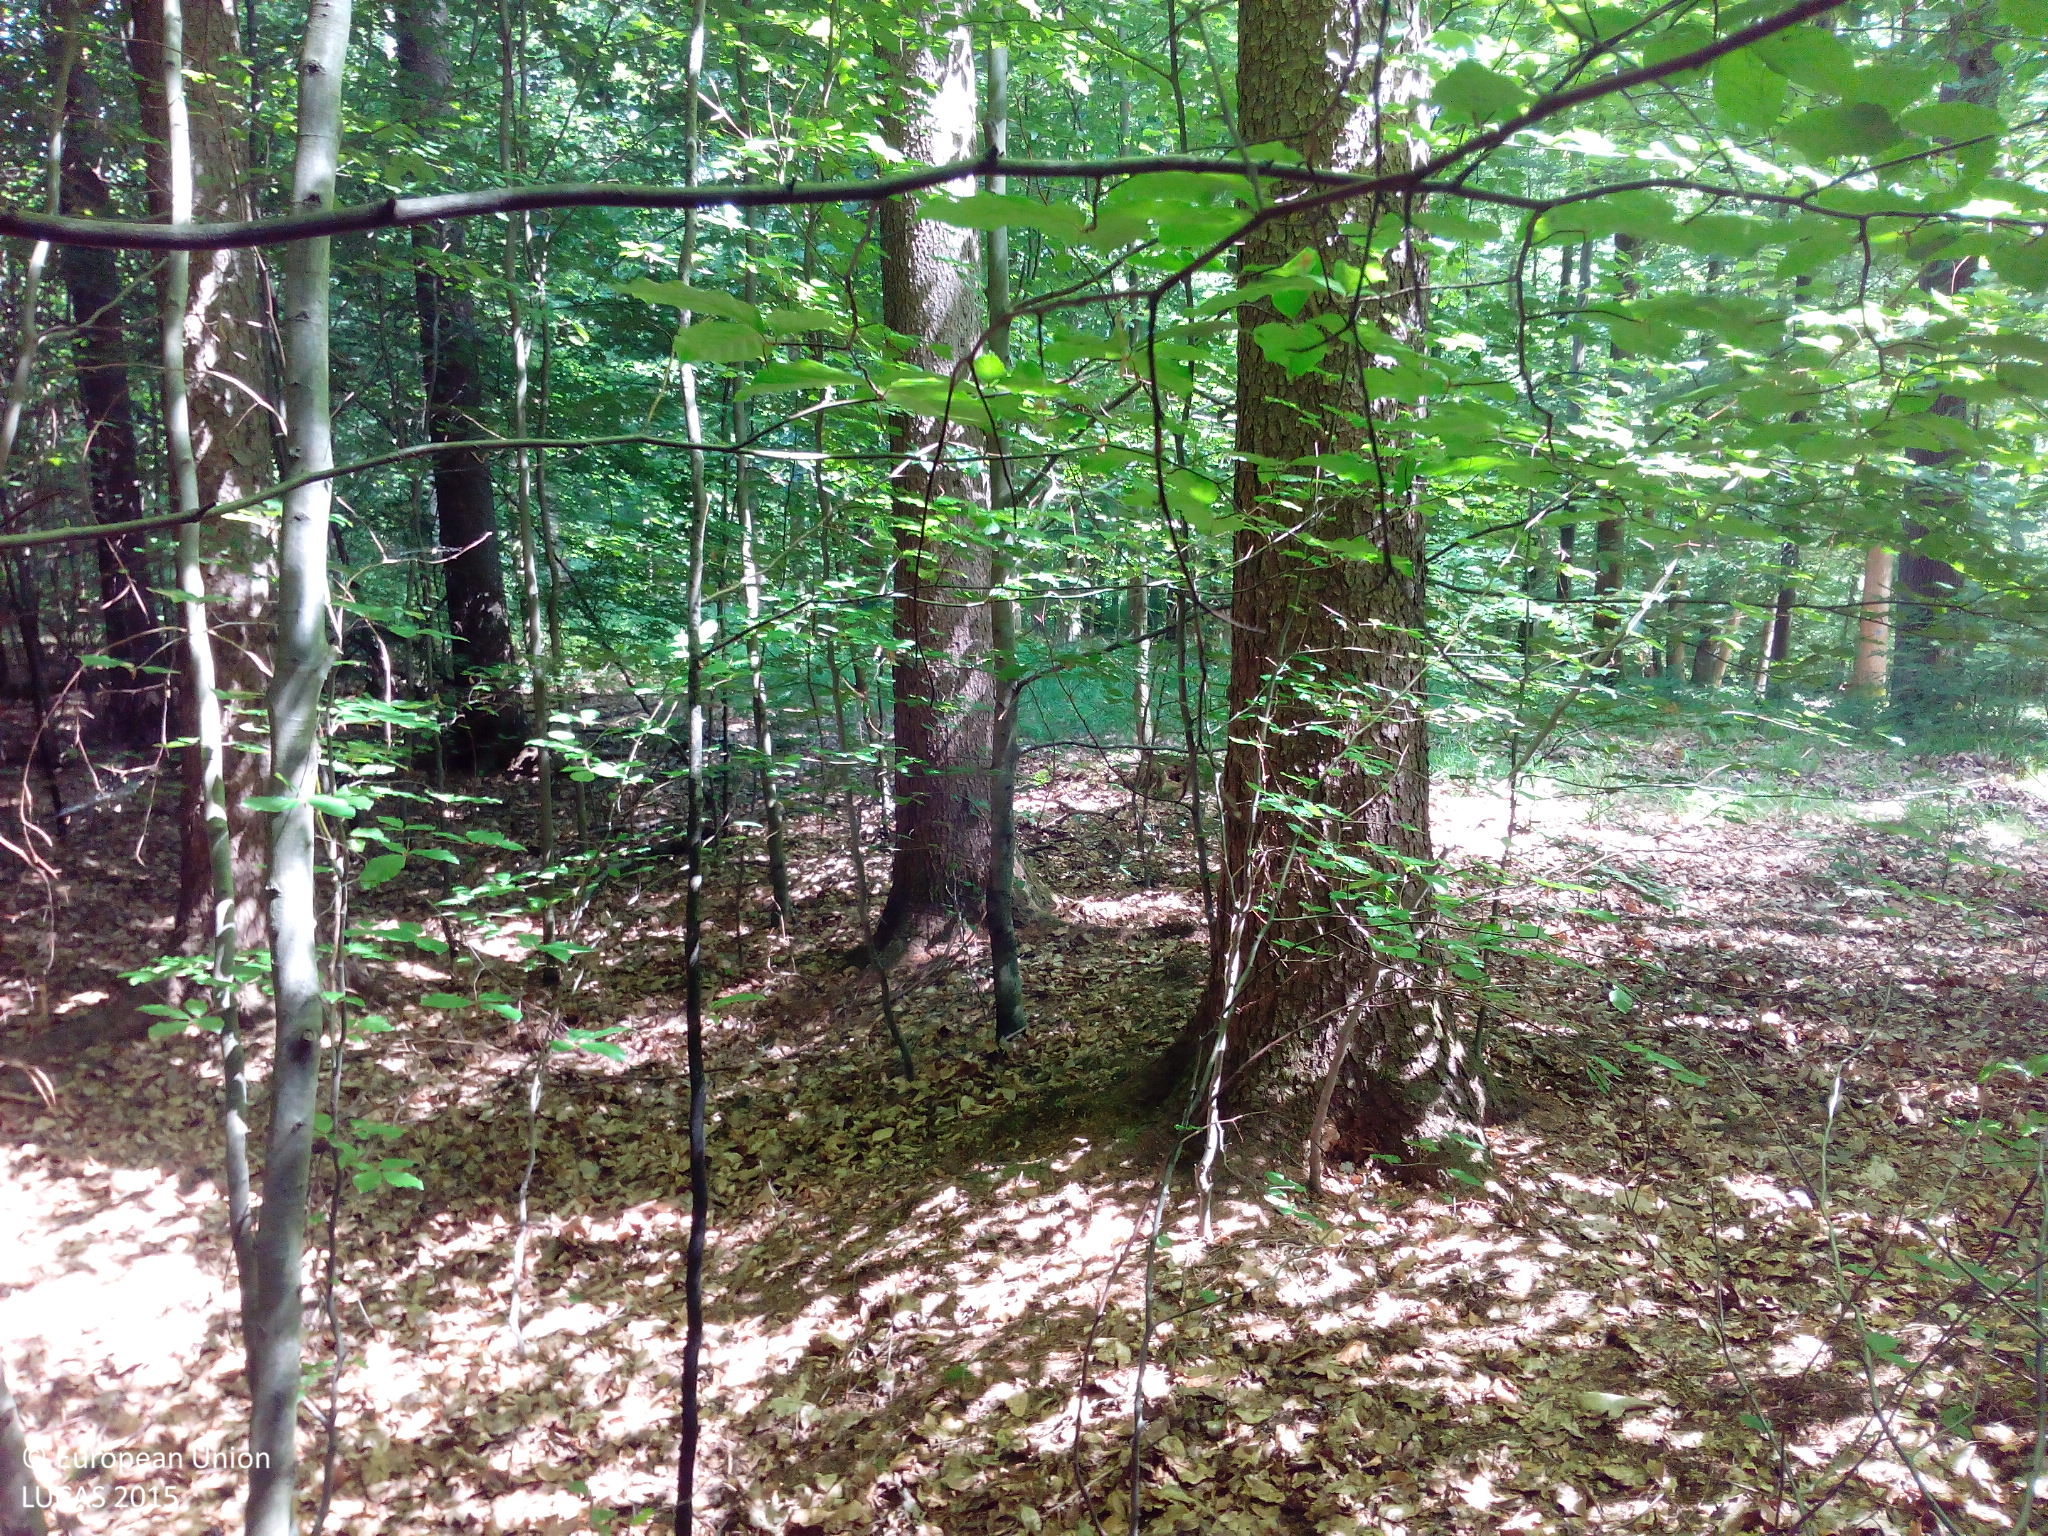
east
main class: Woodland
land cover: Spruce dominated mixed woodland
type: hemiboreal forest and nemoral coniferous forest and mixed broadleaved-coniferous forest
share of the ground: > 75 %
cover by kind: coniferous forest trees 60 %, broadleaved forest trees 40 %
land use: Forestry
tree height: > 5 m
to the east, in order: Spruce dominated mixed woodland; Broadleaved woodland; Tracks; Broadleaved woodland; Tracks; Broadleaved woodland; Spruce dominated coniferous woodland
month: June
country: DE
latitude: 49.1574
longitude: 9.3832
